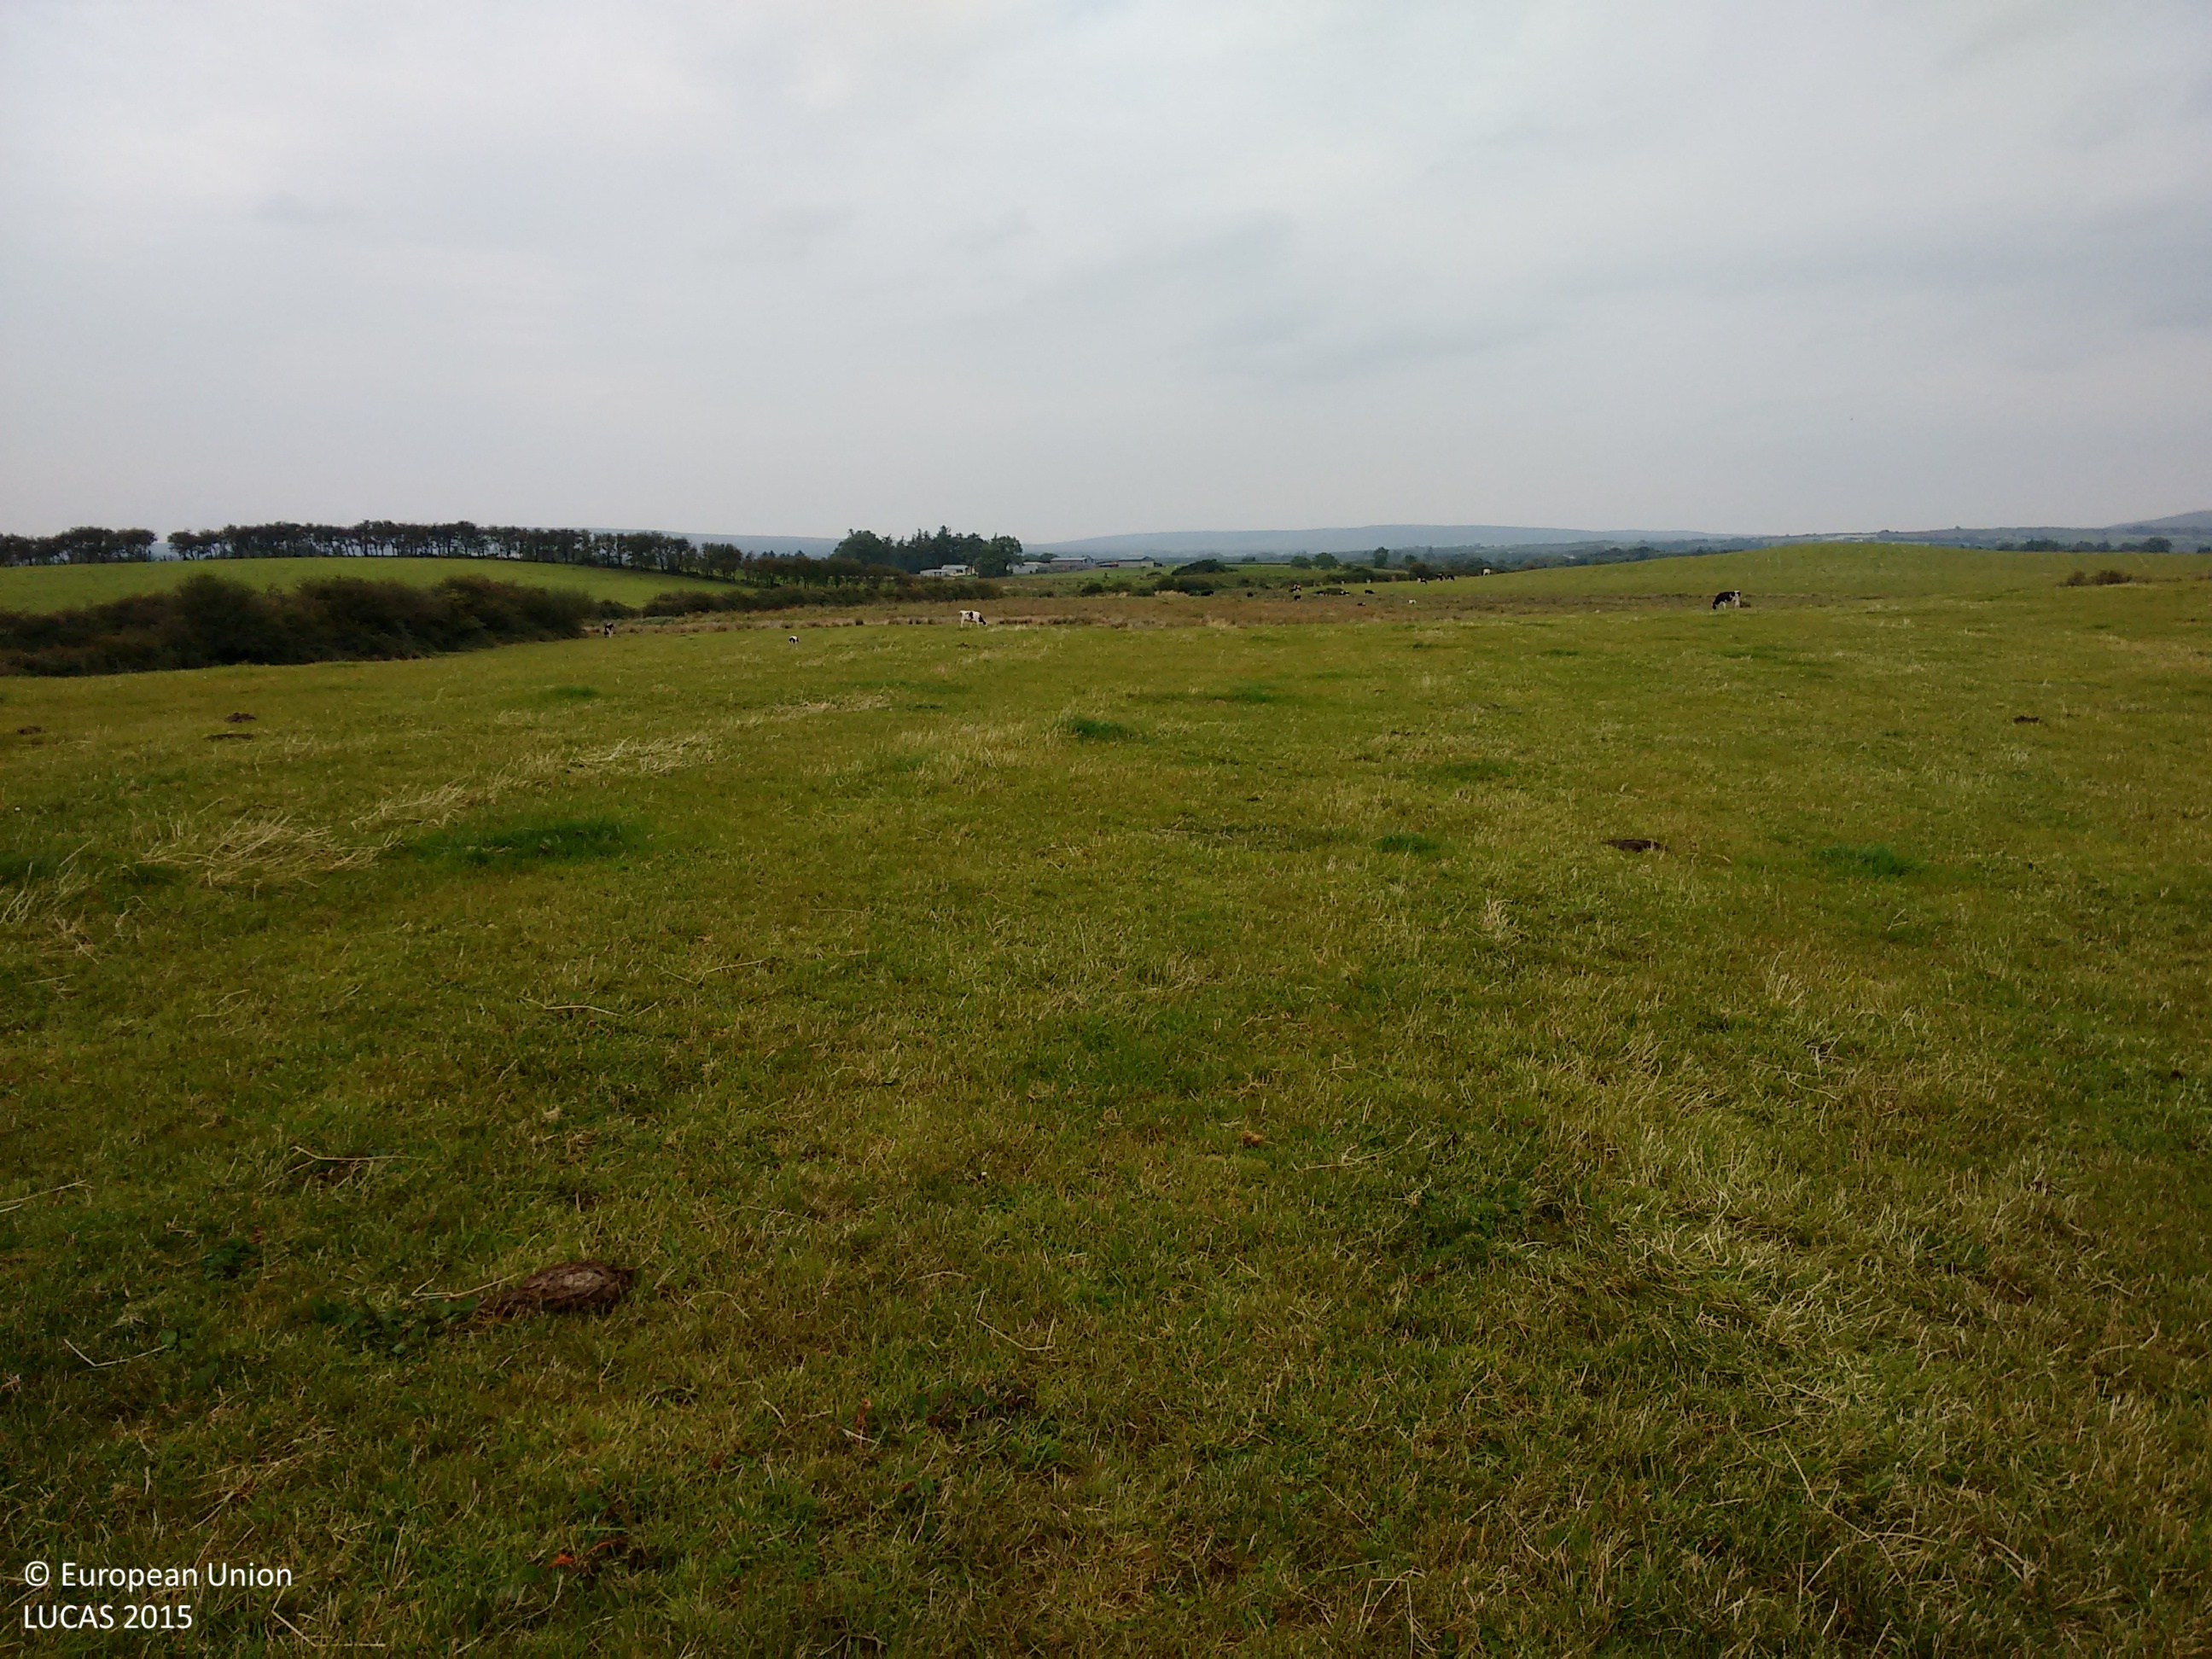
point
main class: Grassland
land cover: Grassland without tree/shrub cover
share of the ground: > 75 %
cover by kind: herbaceous plants 100 %
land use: Agriculture (excluding fallow land and kitchen gardens)
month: September
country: IE
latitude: 54.1977
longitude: -9.3073
